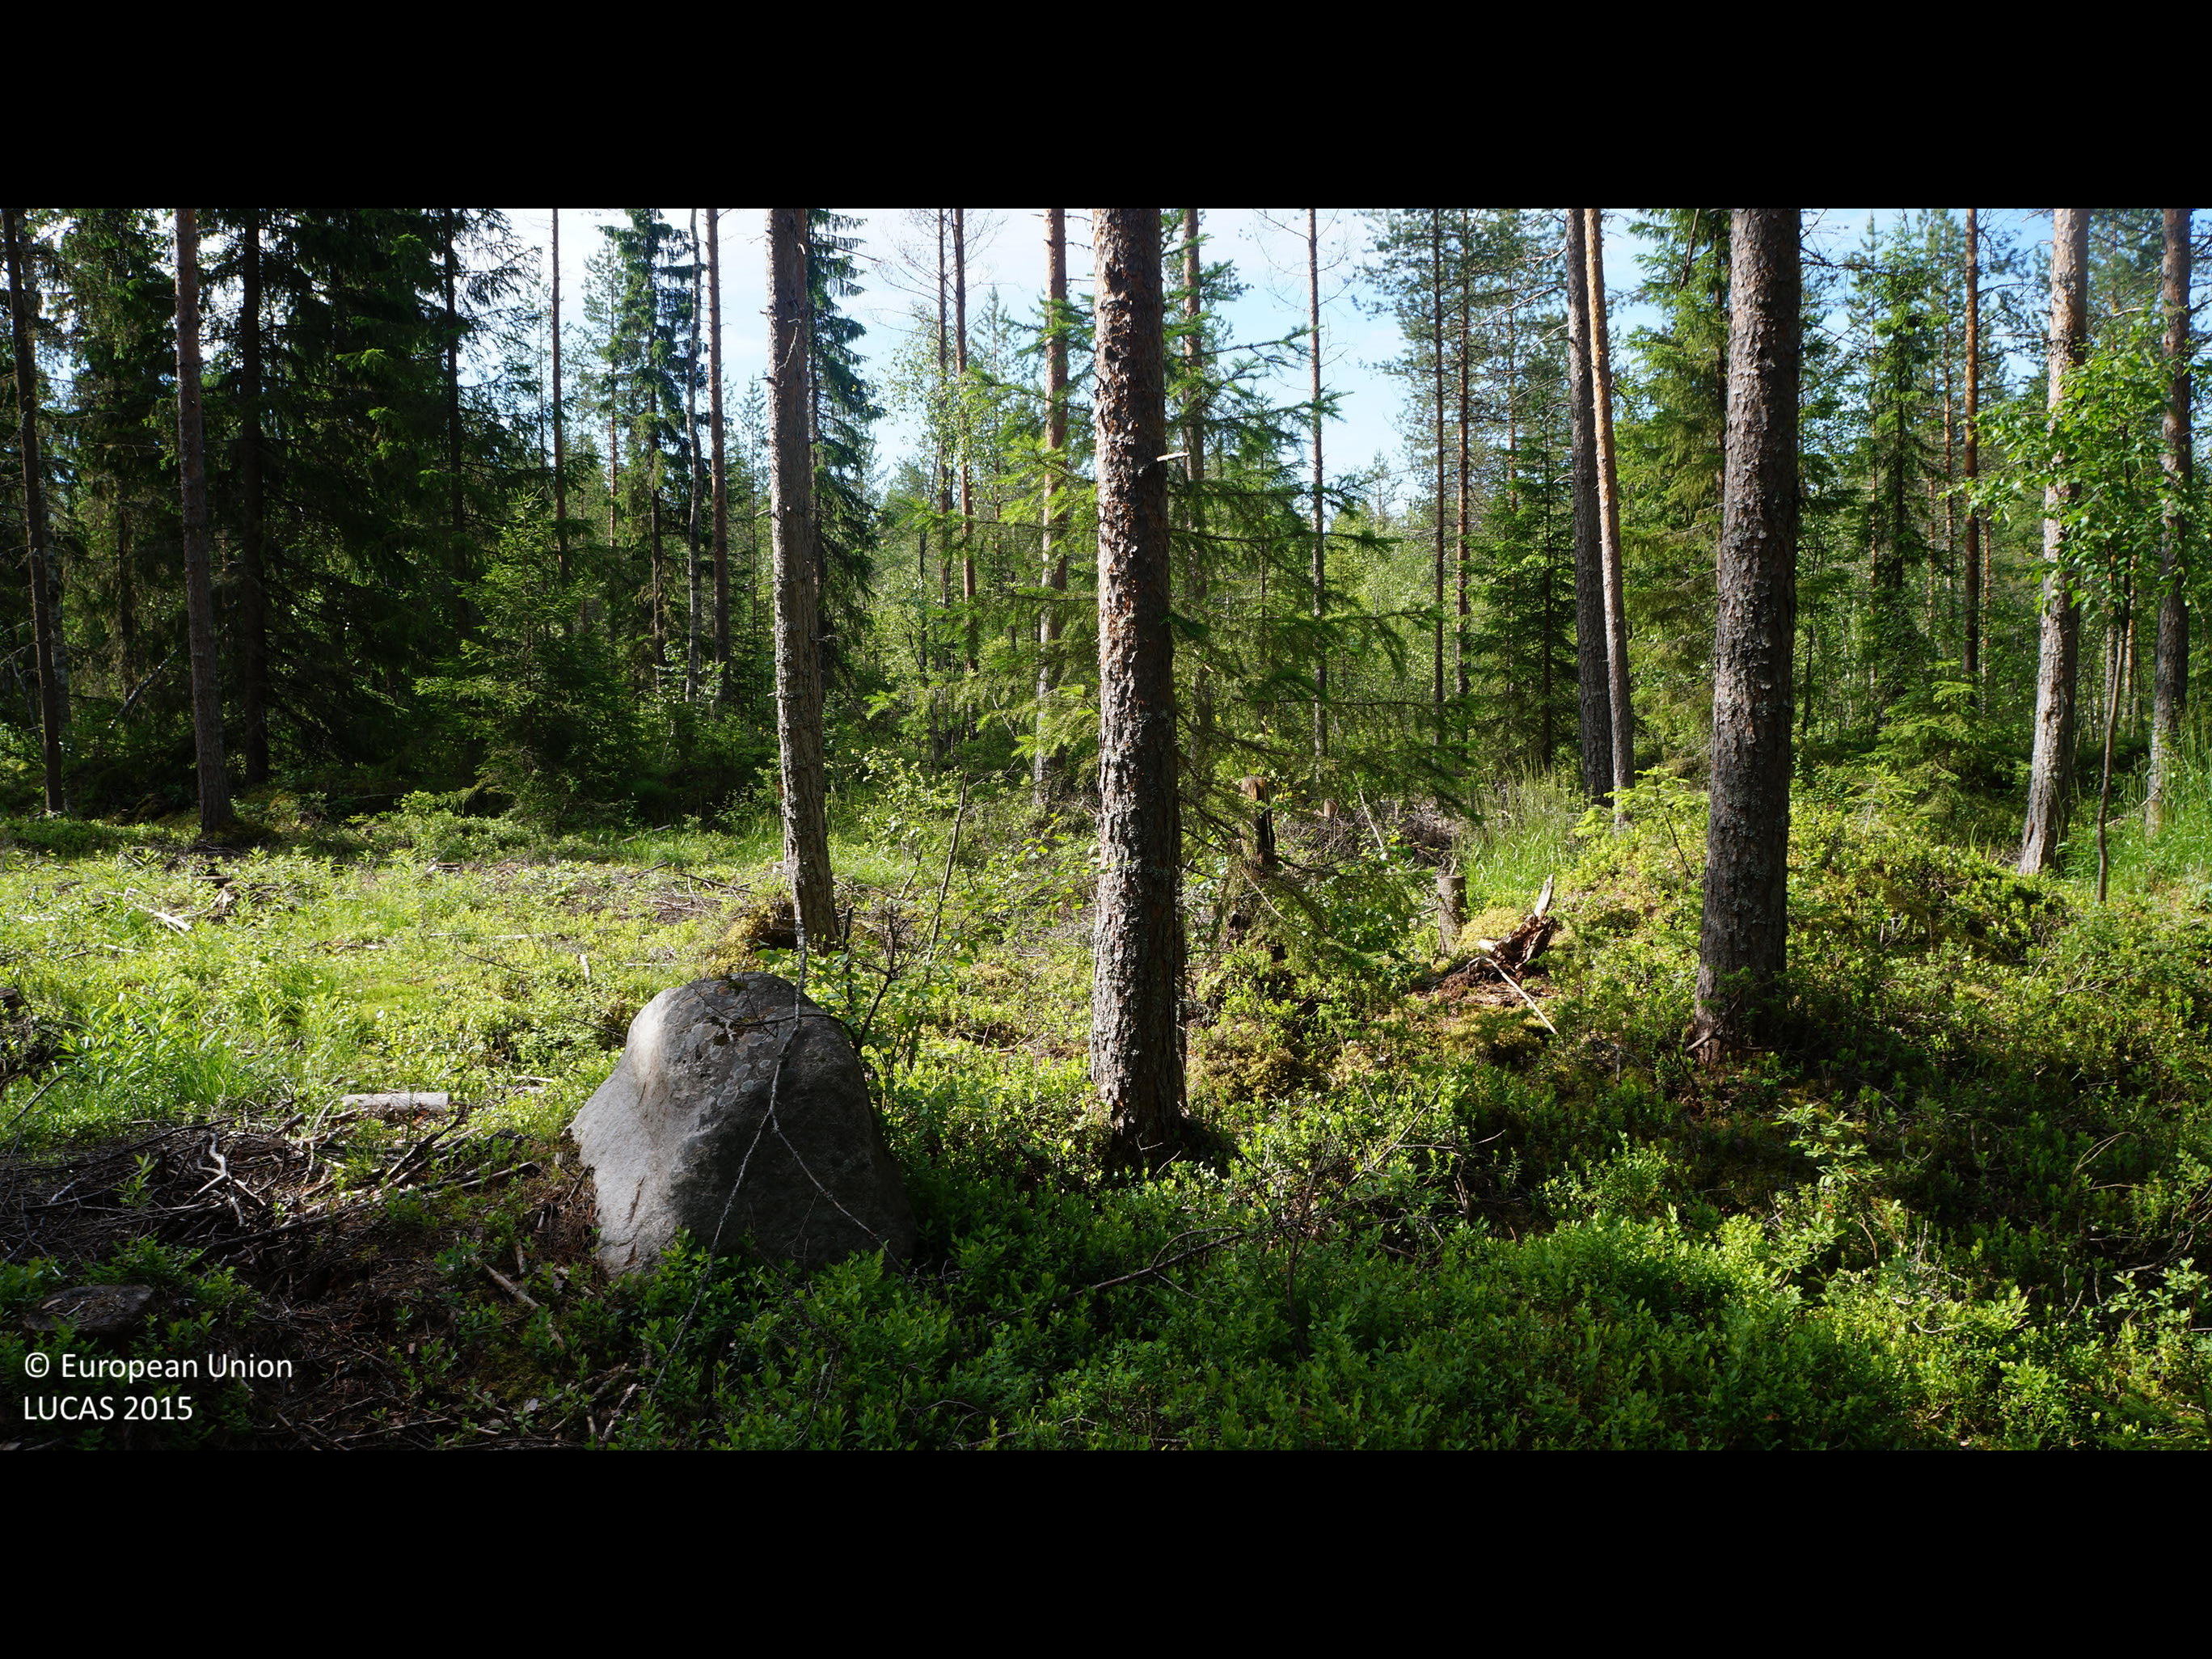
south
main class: Woodland
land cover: Spruce dominated coniferous woodland
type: boreal forest
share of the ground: 50 - 75 %
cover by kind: coniferous forest trees 50 %, shrubs 35 %, lichens and mosses 10 %, broadleaved forest trees 5 %
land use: Forestry
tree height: > 5 m
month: July
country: FI
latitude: 64.3462
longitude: 24.5847
